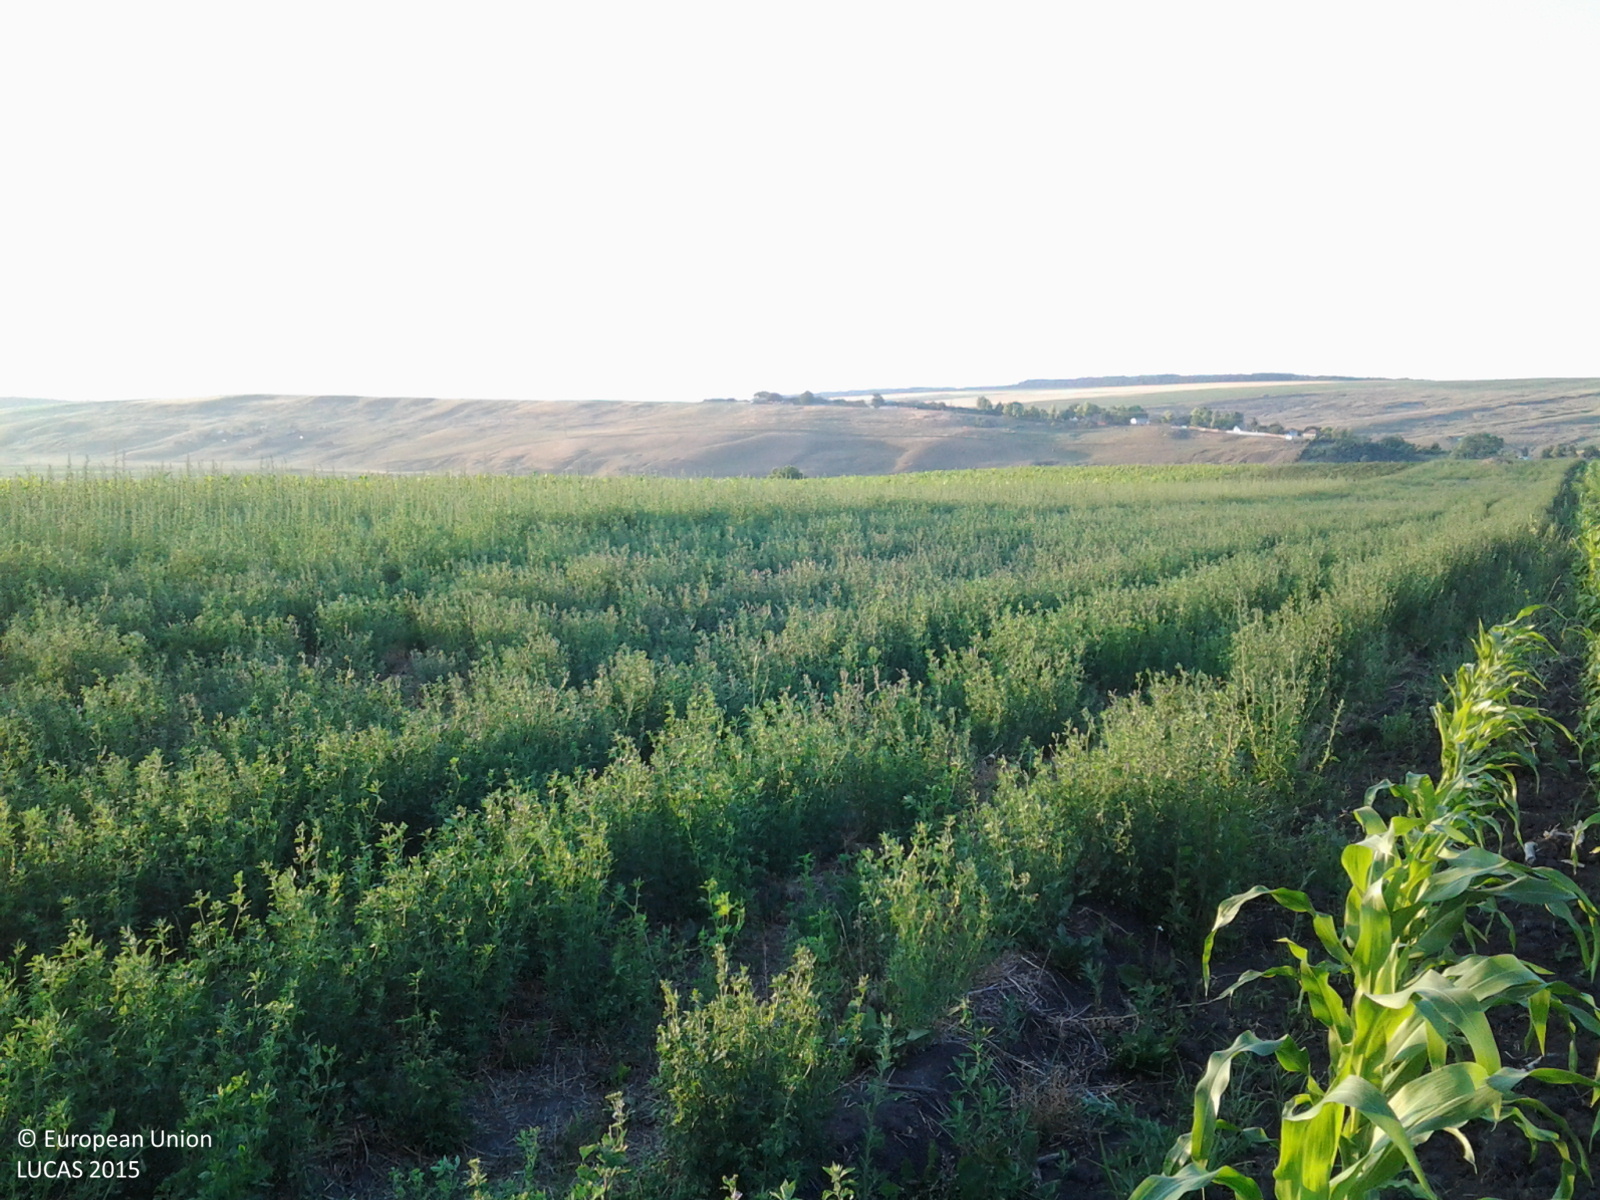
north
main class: Cropland
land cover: Maize
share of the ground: 50 - 75 %
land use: Agriculture (excluding fallow land and kitchen gardens)
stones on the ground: < 10 %
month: June
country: RO
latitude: 47.5654
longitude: 26.9151
